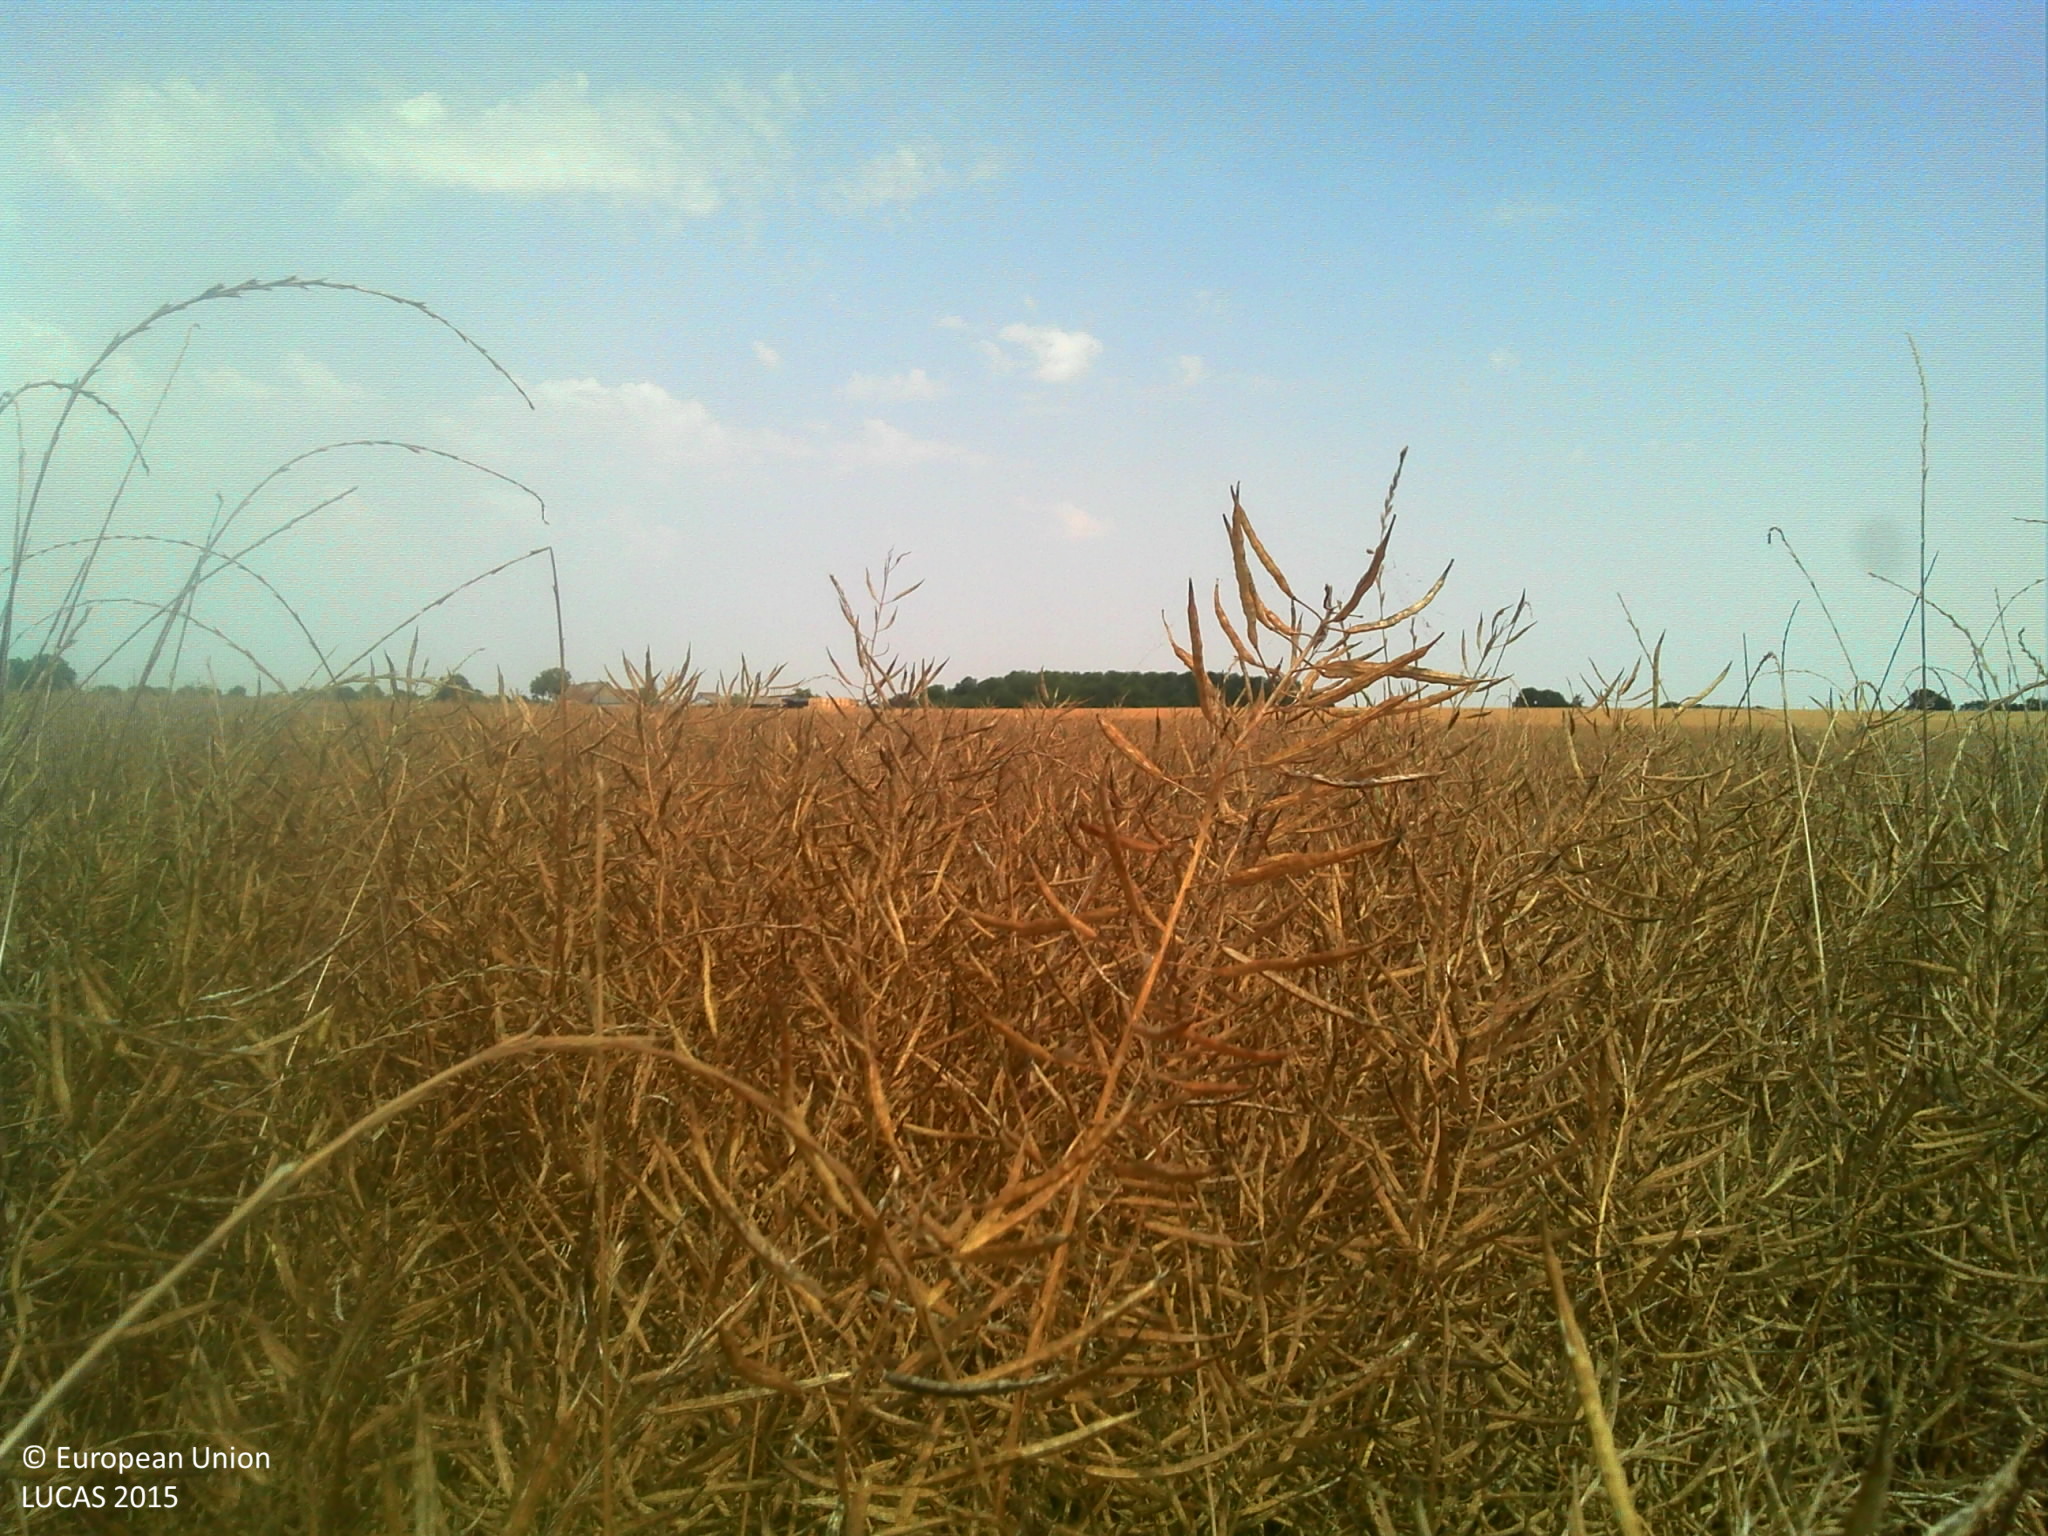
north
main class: Cropland
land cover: Rape and turnip rape
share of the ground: > 75 %
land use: Agriculture (excluding fallow land and kitchen gardens)
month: July
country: FR
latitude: 48.1501
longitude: 1.0692
